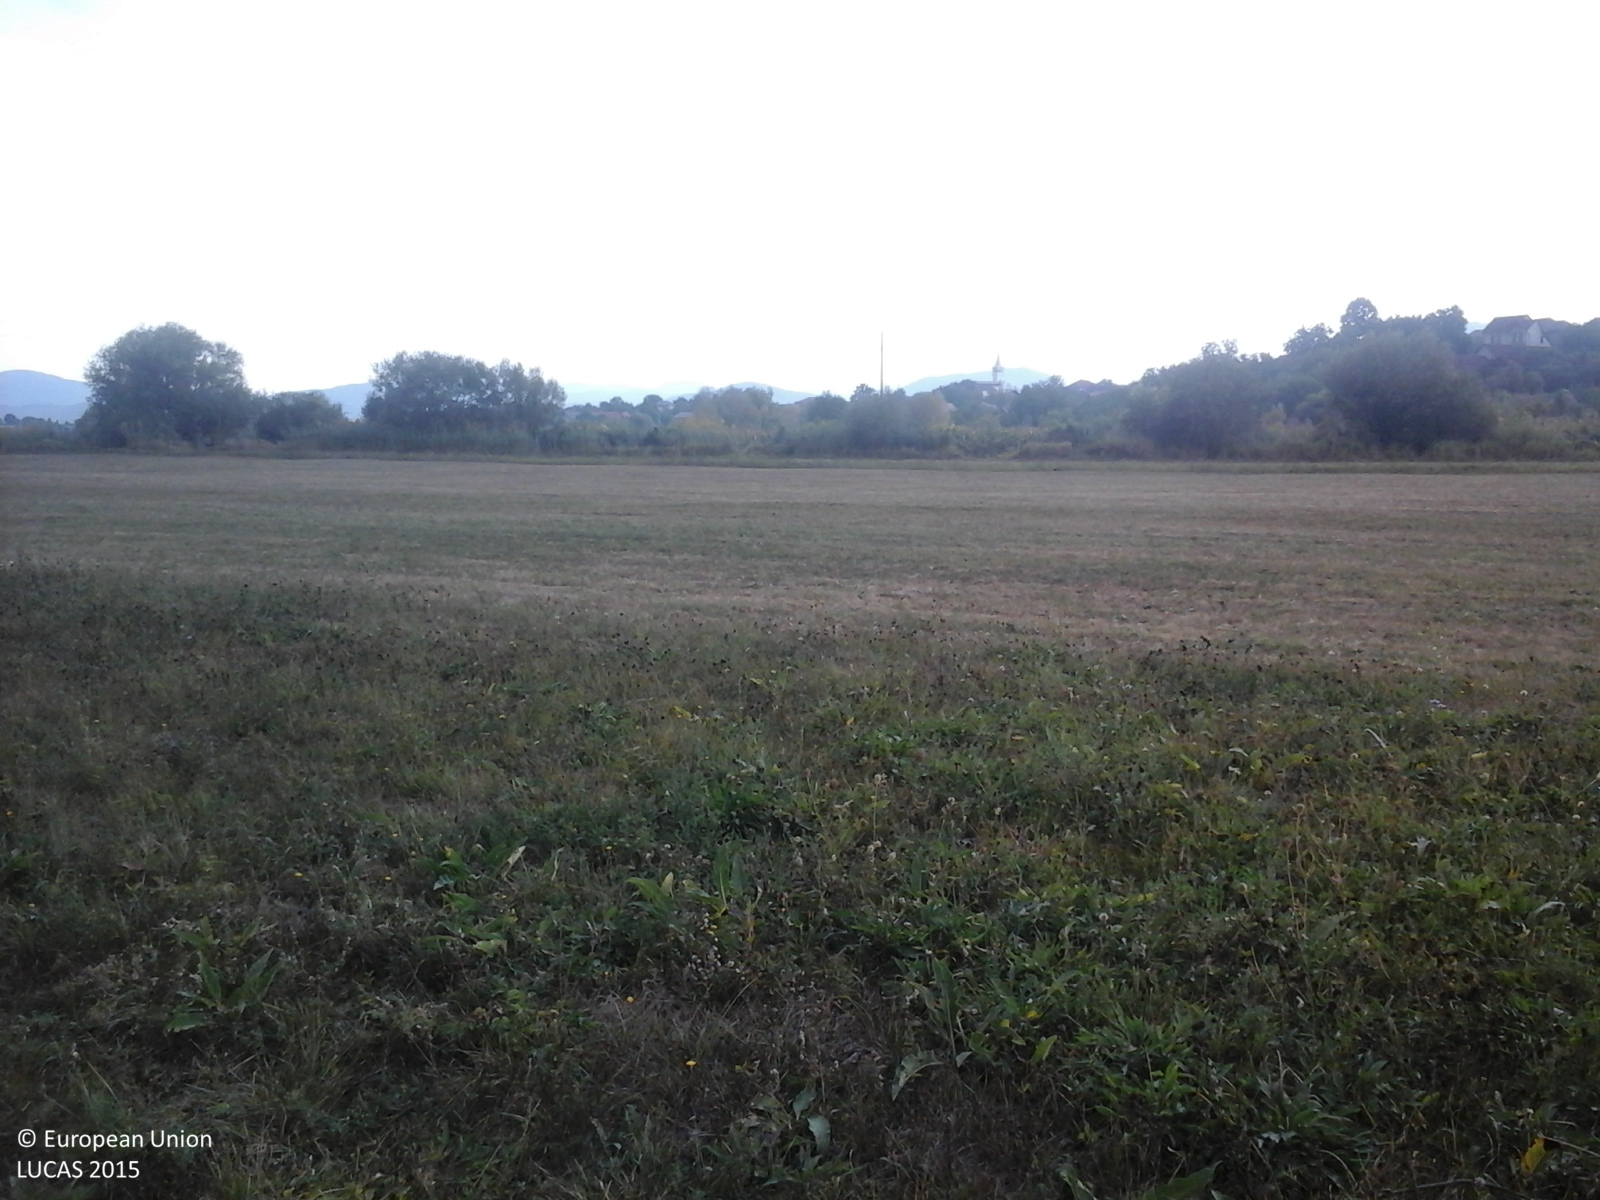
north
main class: Grassland
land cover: Grassland without tree/shrub cover
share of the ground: > 75 %
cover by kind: herbaceous plants 100 %
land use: Agriculture (excluding fallow land and kitchen gardens)
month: September
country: RO
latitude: 47.6254
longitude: 23.5011
